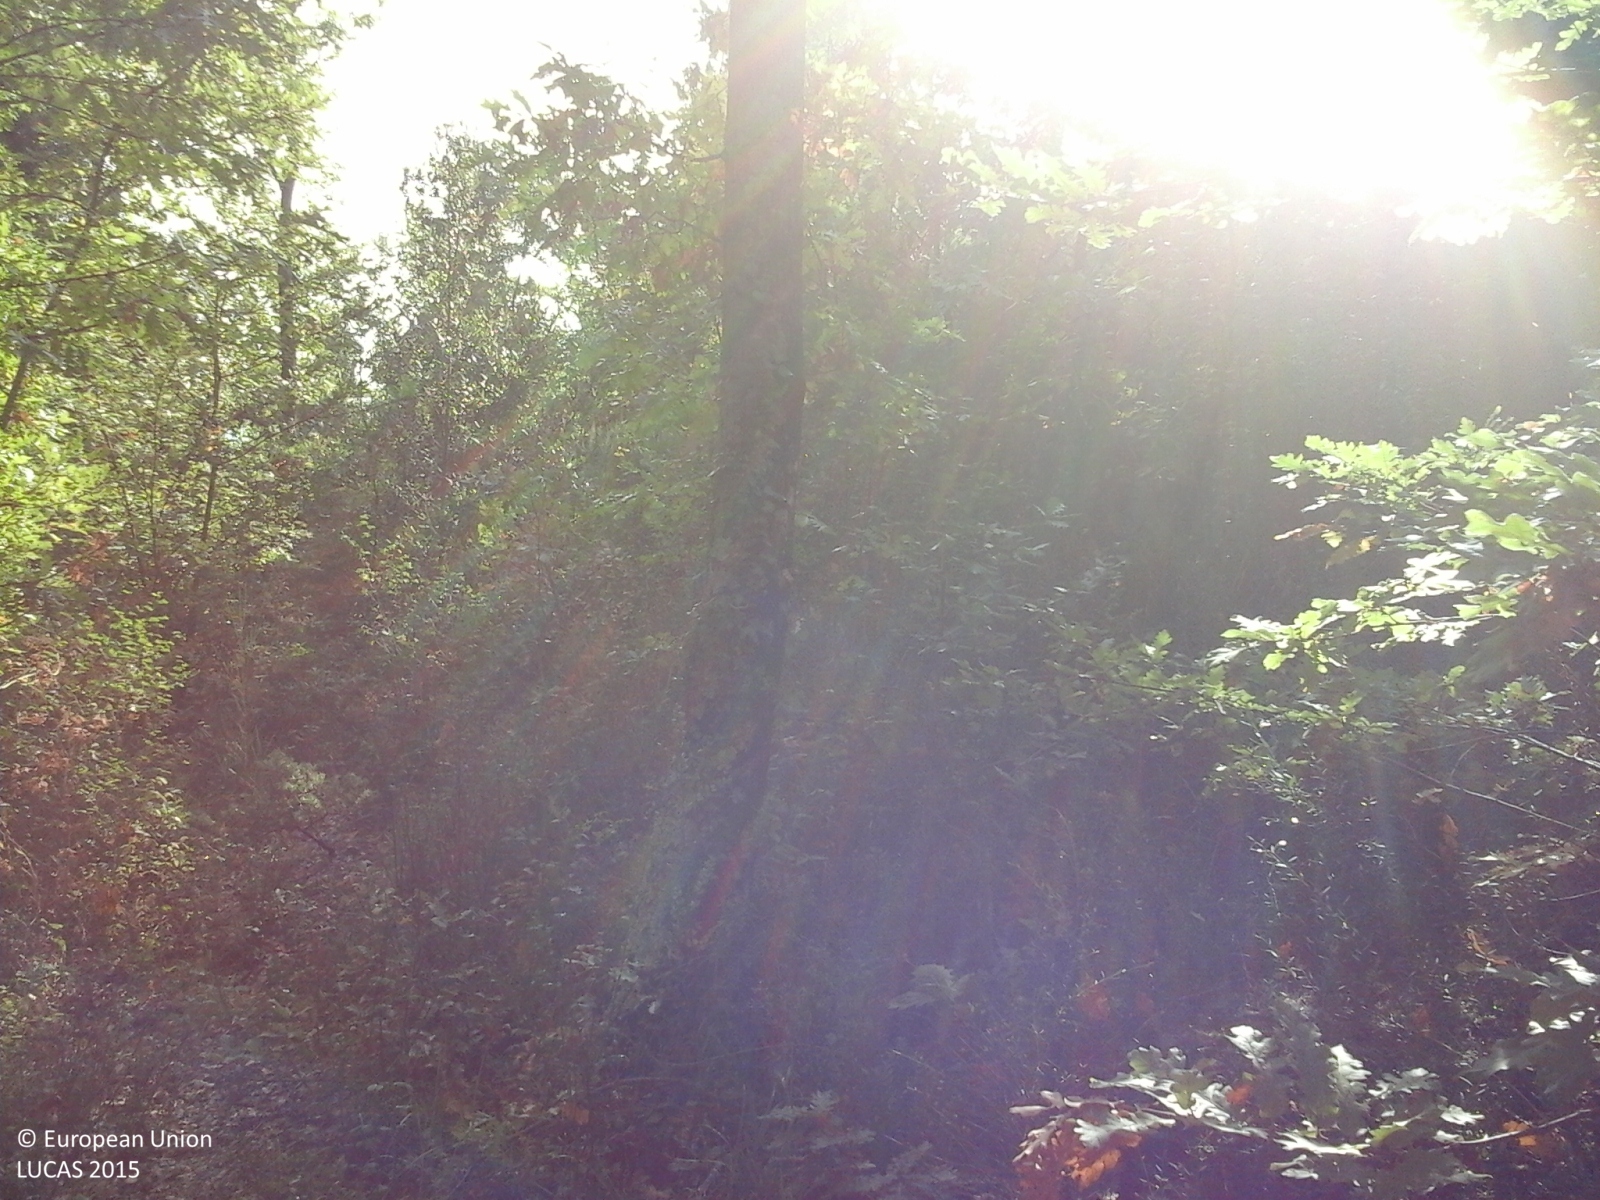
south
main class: Woodland
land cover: Broadleaved woodland
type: thermophilous deciduous forest
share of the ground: > 75 %
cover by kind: broadleaved forest trees 100 %
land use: Forestry
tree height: > 5 m
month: October
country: IT
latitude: 42.7666
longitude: 12.5462
